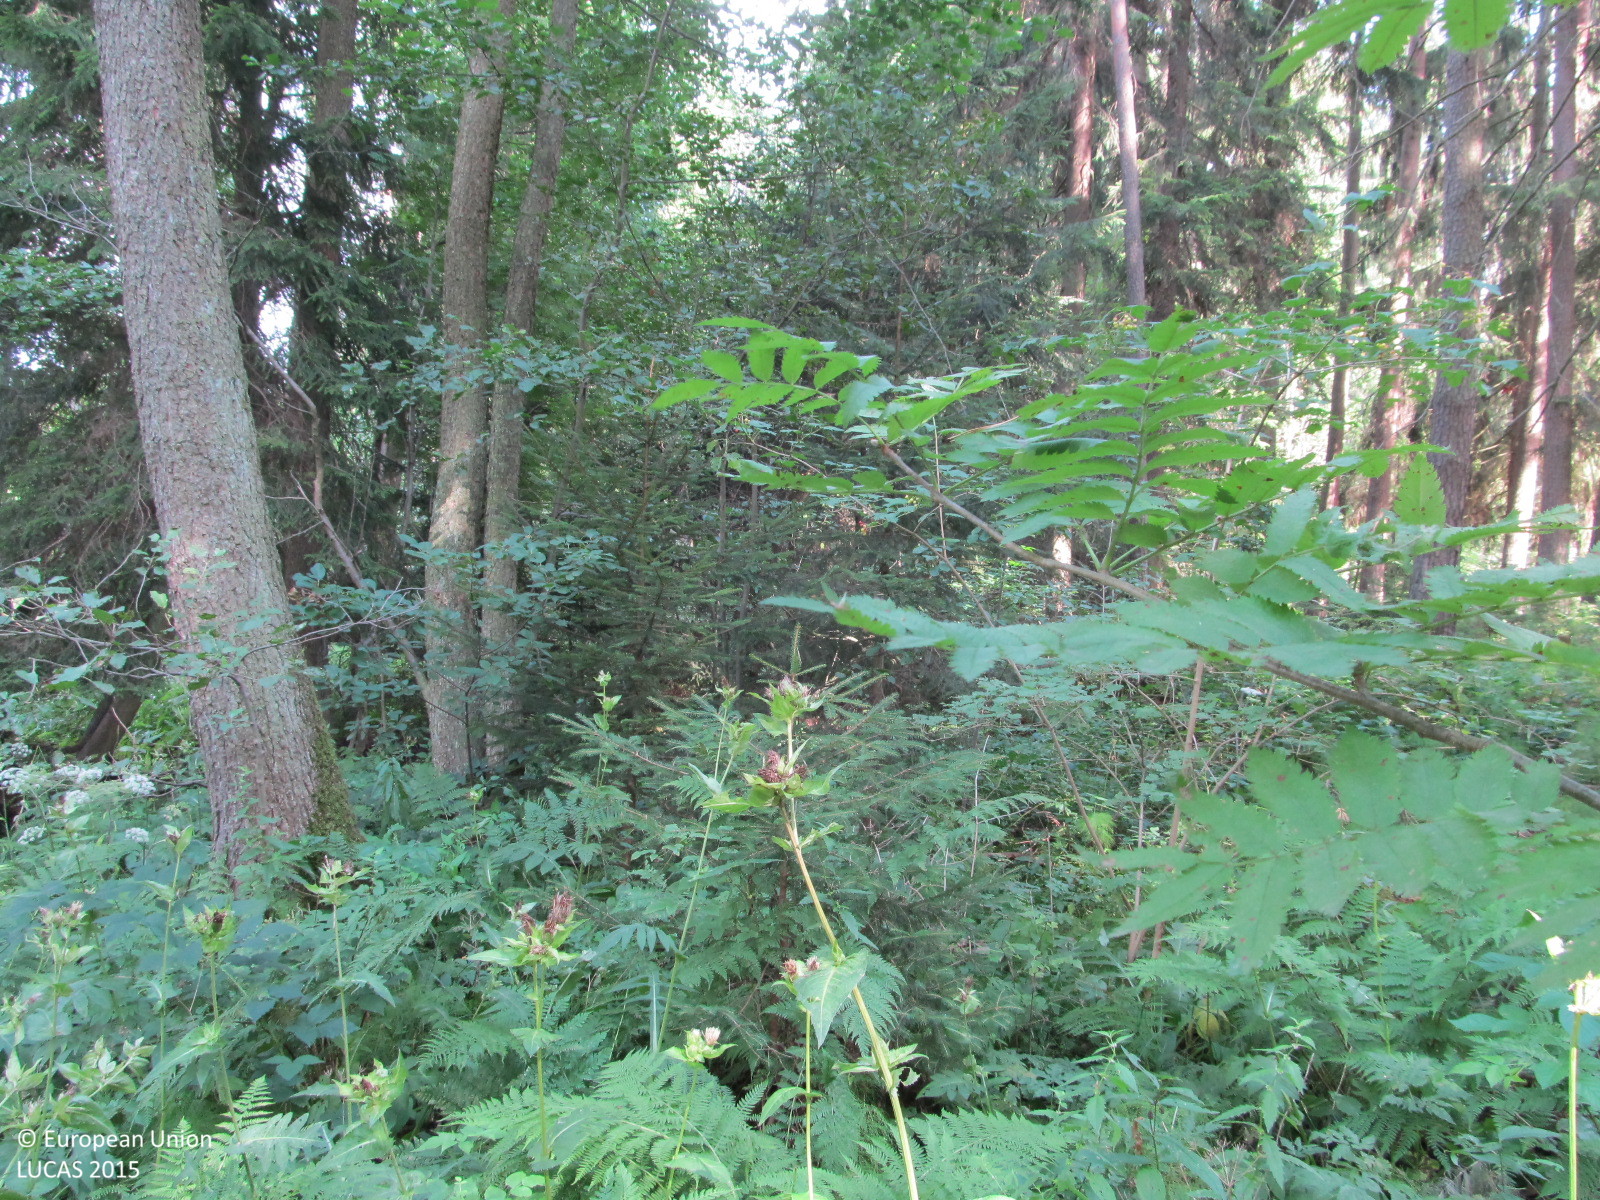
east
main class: Woodland
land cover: Broadleaved woodland
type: floodplain forest
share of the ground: 50 - 75 %
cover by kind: broadleaved forest trees 70 %, shrubs 20 %, herbaceous plants 10 %
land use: Forestry
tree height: > 5 m
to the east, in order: Broadleaved woodland; Spruce dominated coniferous woodland; Spruce dominated mixed woodland; Broadleaved woodland
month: August
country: AT
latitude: 48.7364
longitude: 15.4826
